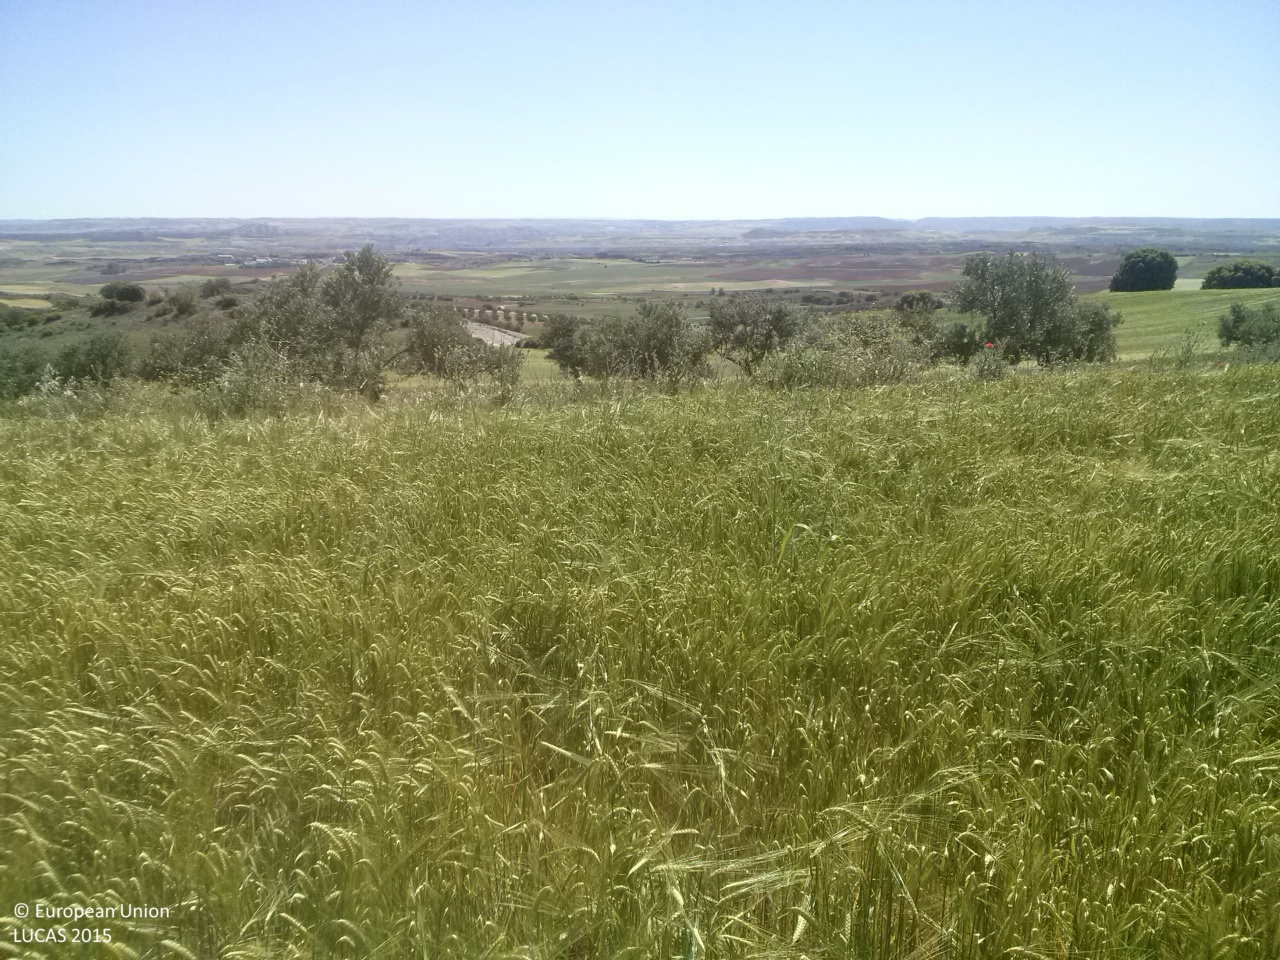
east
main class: Cropland
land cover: Barley
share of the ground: > 75 %
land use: Agriculture (excluding fallow land and kitchen gardens)
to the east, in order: Barley; Grass margins; Olive groves; Barley; Broadleaved woodland; Shrubland without tree cover; Pine dominated coniferous woodland; Grassland without tree/shrub cover; Common wheat
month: May
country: ES
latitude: 40.1736
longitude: -2.8119
